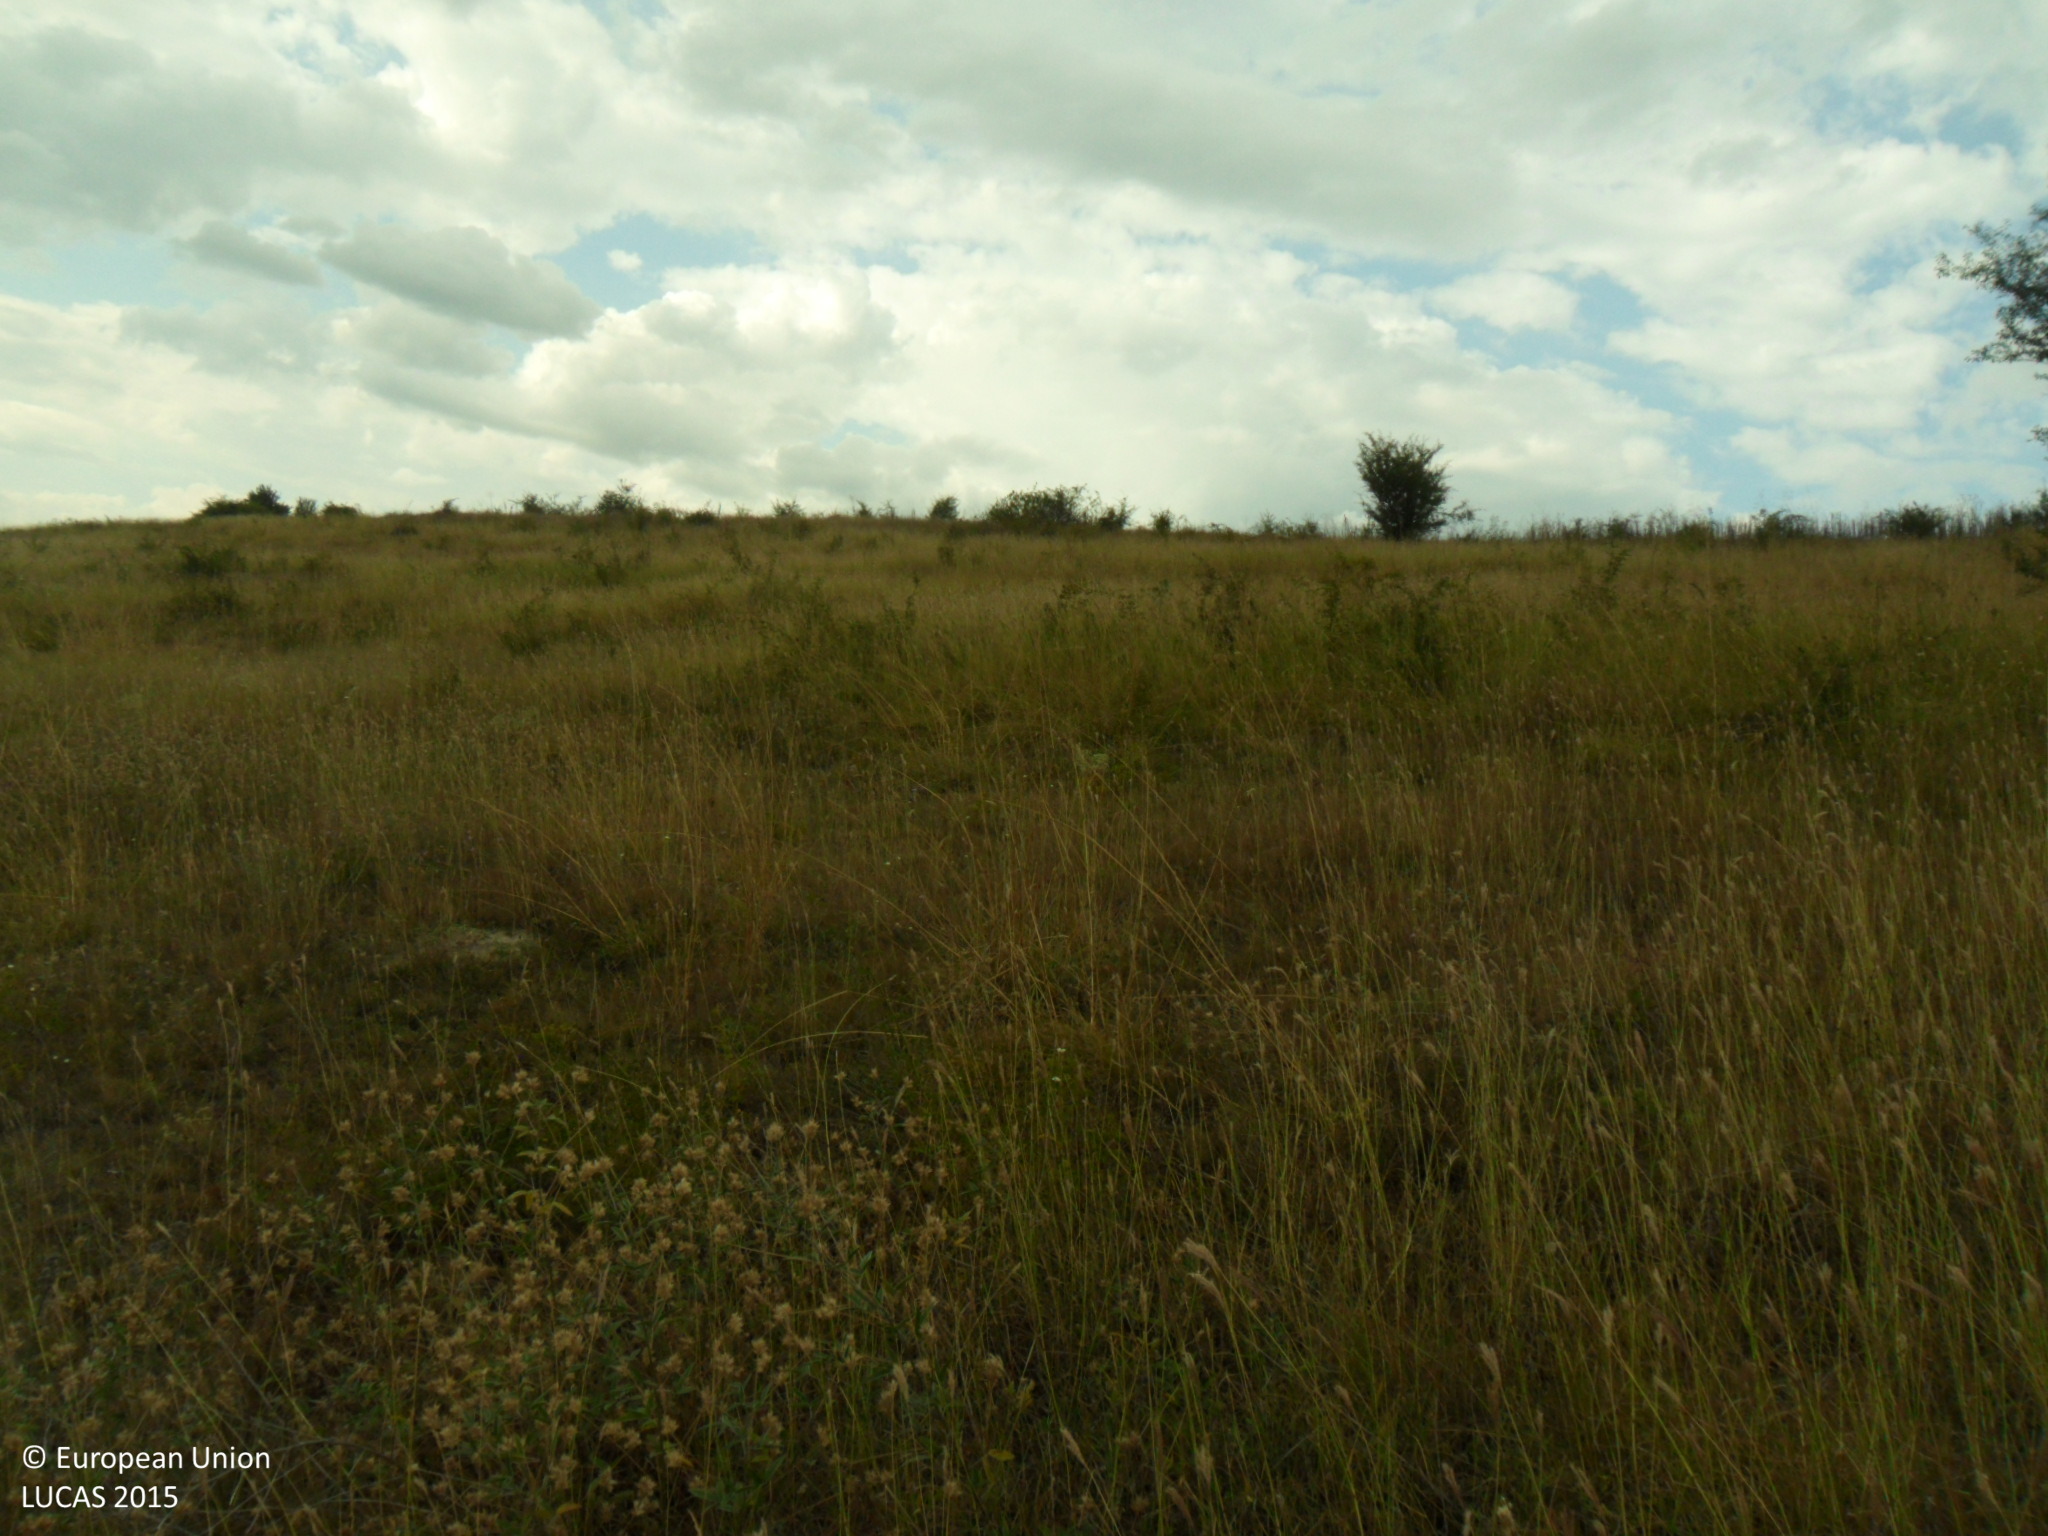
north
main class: Grassland
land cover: Grassland with sparse tree/shrub cover
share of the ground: > 75 %
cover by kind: herbaceous plants 90 %, broadleaved forest trees 5 %, shrubs 5 %
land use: Agriculture (excluding fallow land and kitchen gardens)
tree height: < 5 m
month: August
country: BG
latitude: 43.4822
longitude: 26.5876
